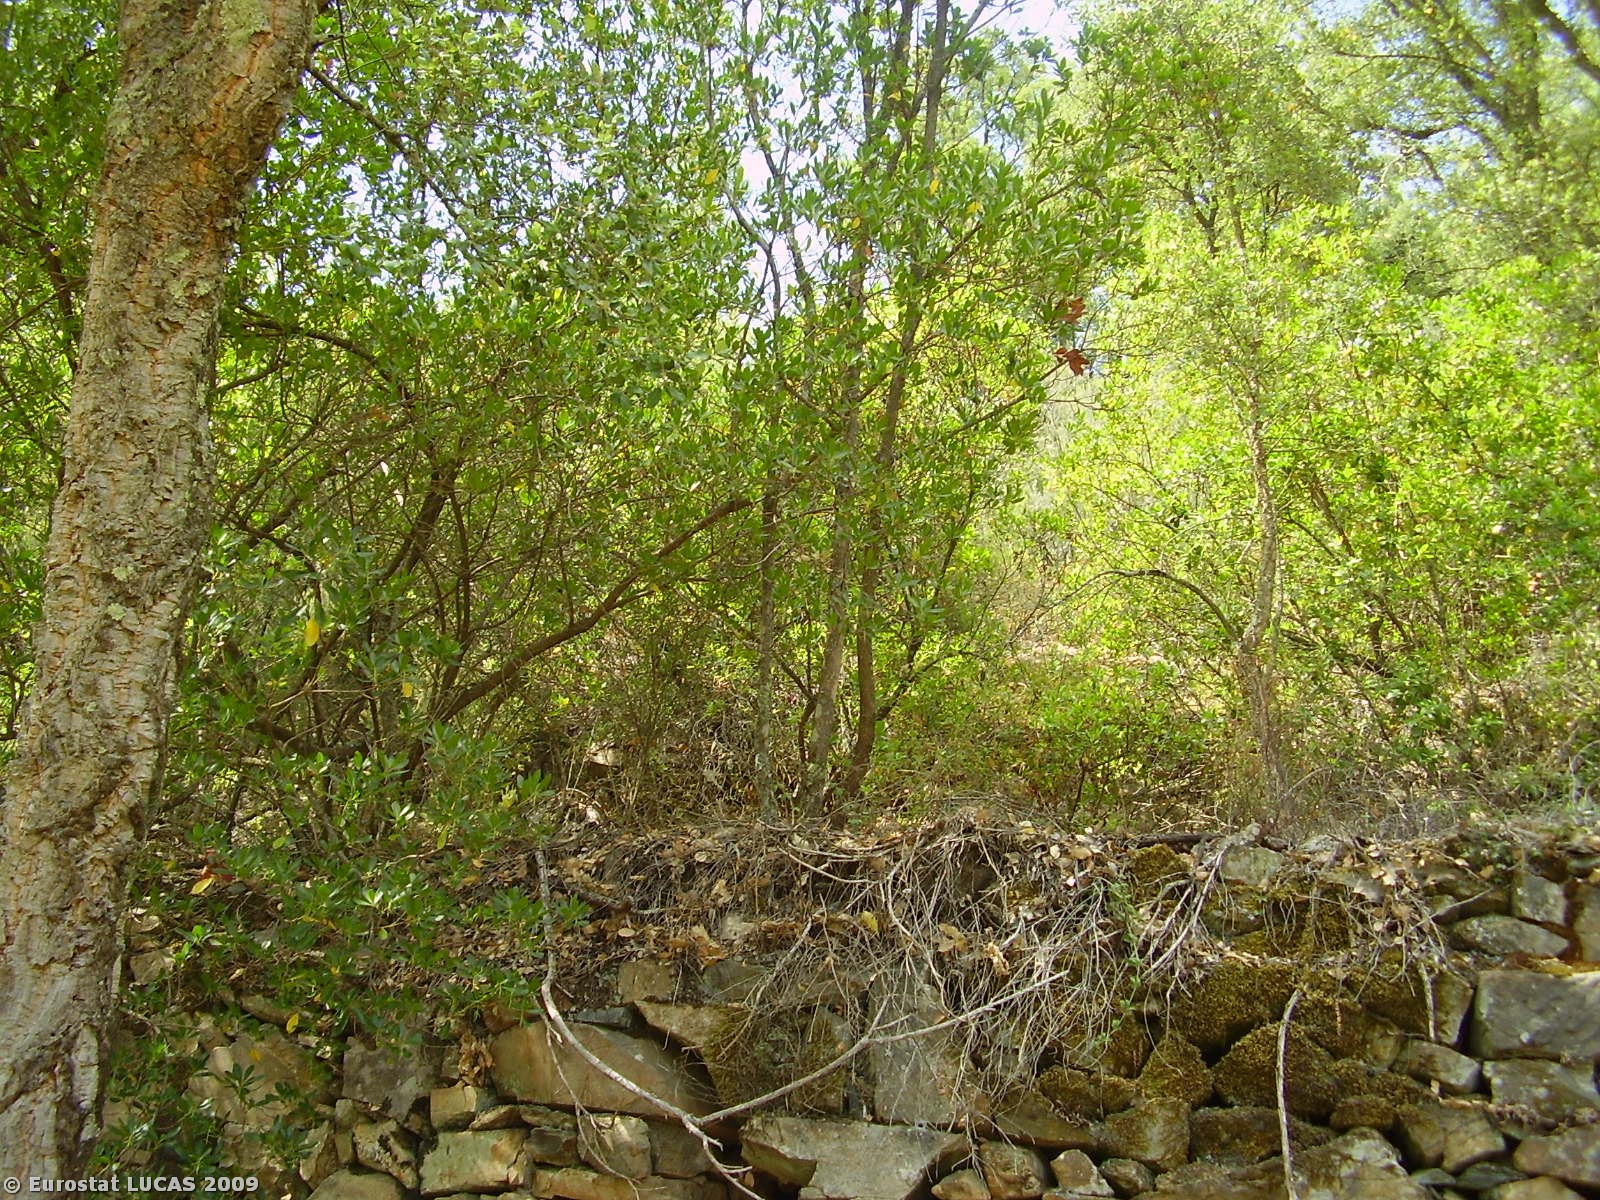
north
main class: Woodland
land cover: Broadleaved woodland
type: broadleaved evergreen forest
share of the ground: > 75 %
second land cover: Spontaneously vegetated surfaces
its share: 10 - 25 %
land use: Unused
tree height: > 5 m
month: July
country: PT
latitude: 41.2188
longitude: -7.6490
